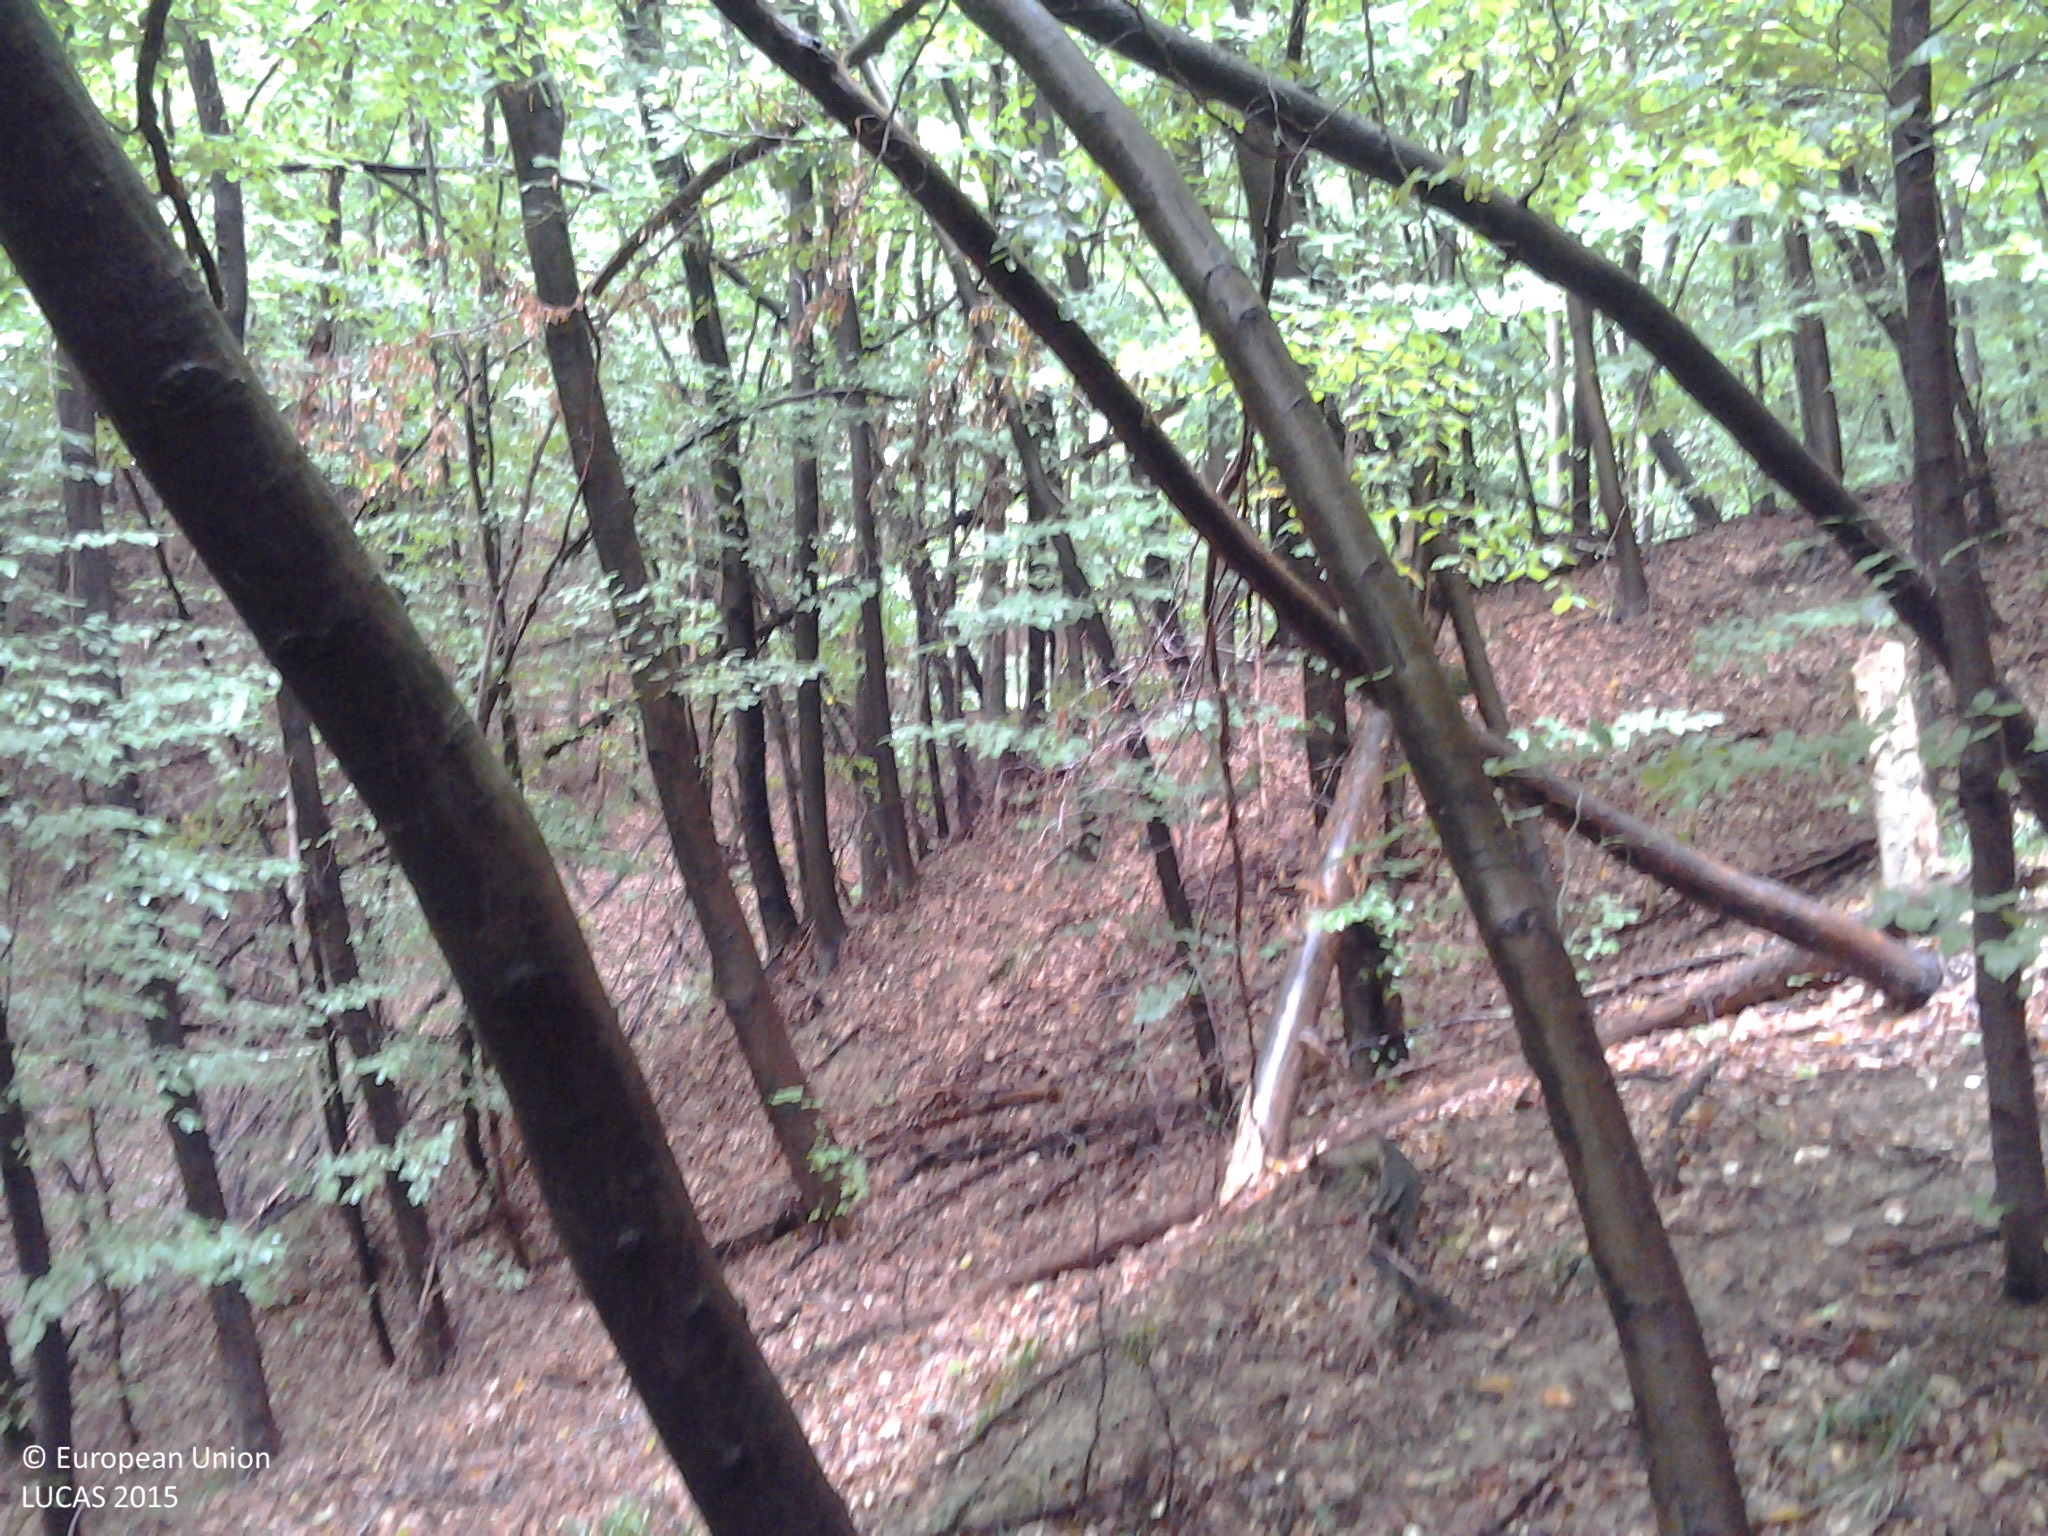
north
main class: Woodland
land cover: Broadleaved woodland
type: beech forest
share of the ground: > 75 %
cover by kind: broadleaved forest trees 100 %
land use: Forestry
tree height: > 5 m
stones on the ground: 10 - 25 %
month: September
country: RO
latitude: 46.9797
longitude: 22.6639
